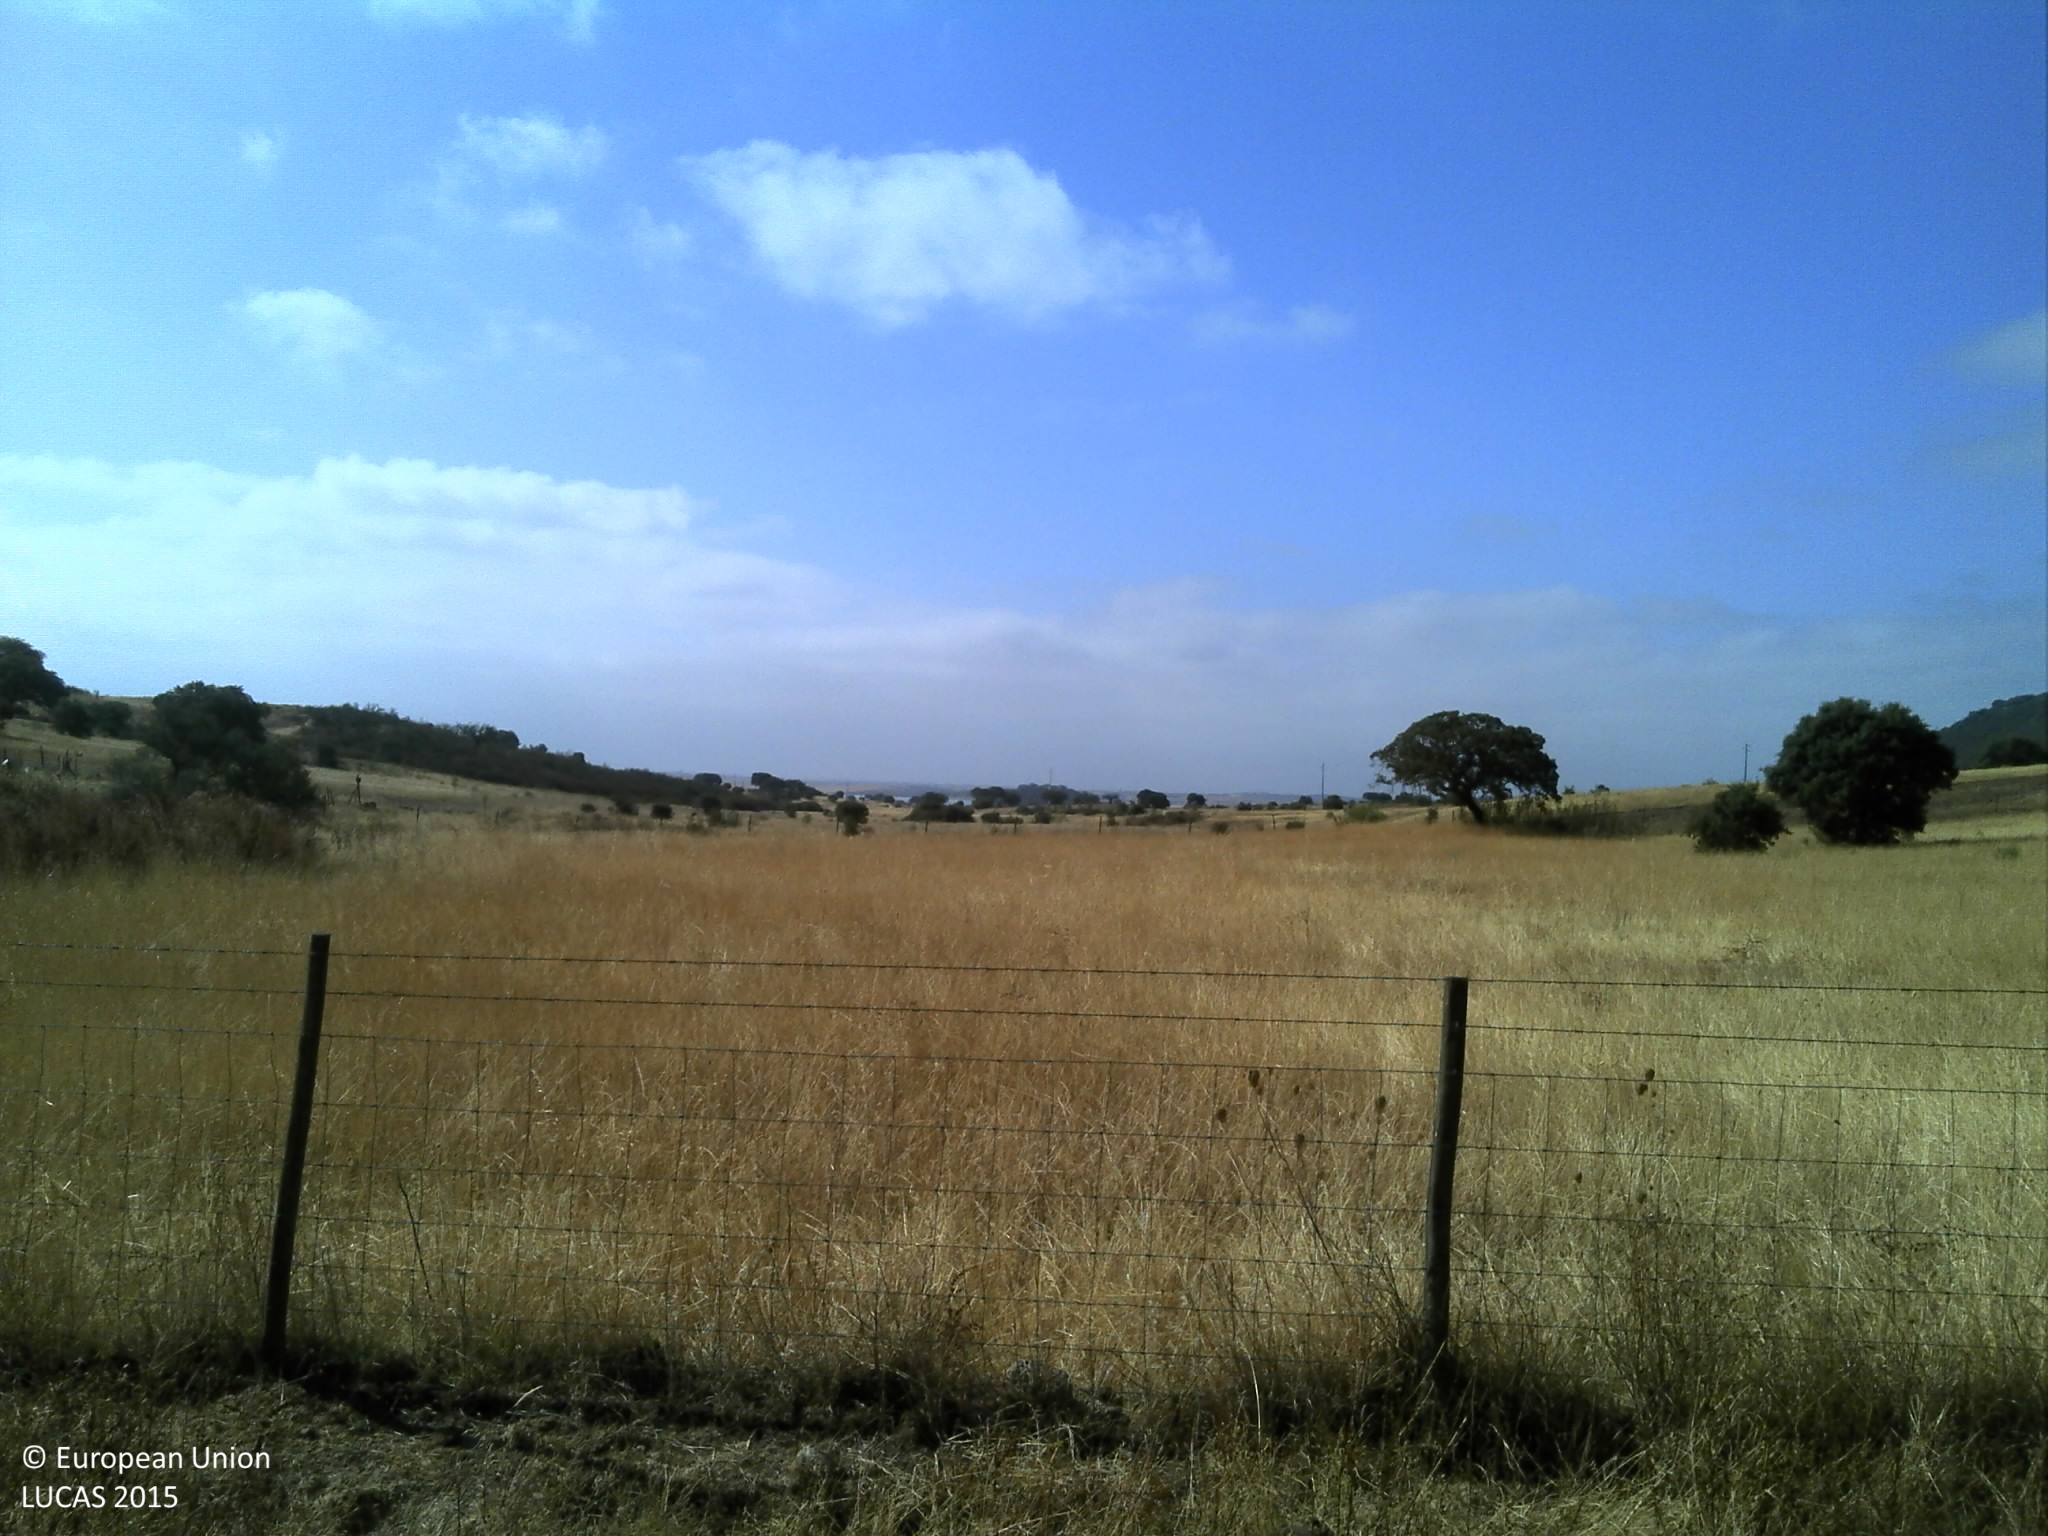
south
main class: Grassland
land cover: Grassland without tree/shrub cover
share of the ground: 25 - 50 %
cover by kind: unconsolidated bare surface 60 %, herbaceous plants 40 %
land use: Agriculture (excluding fallow land and kitchen gardens)
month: July
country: PT
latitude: 38.4477
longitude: -7.3605
